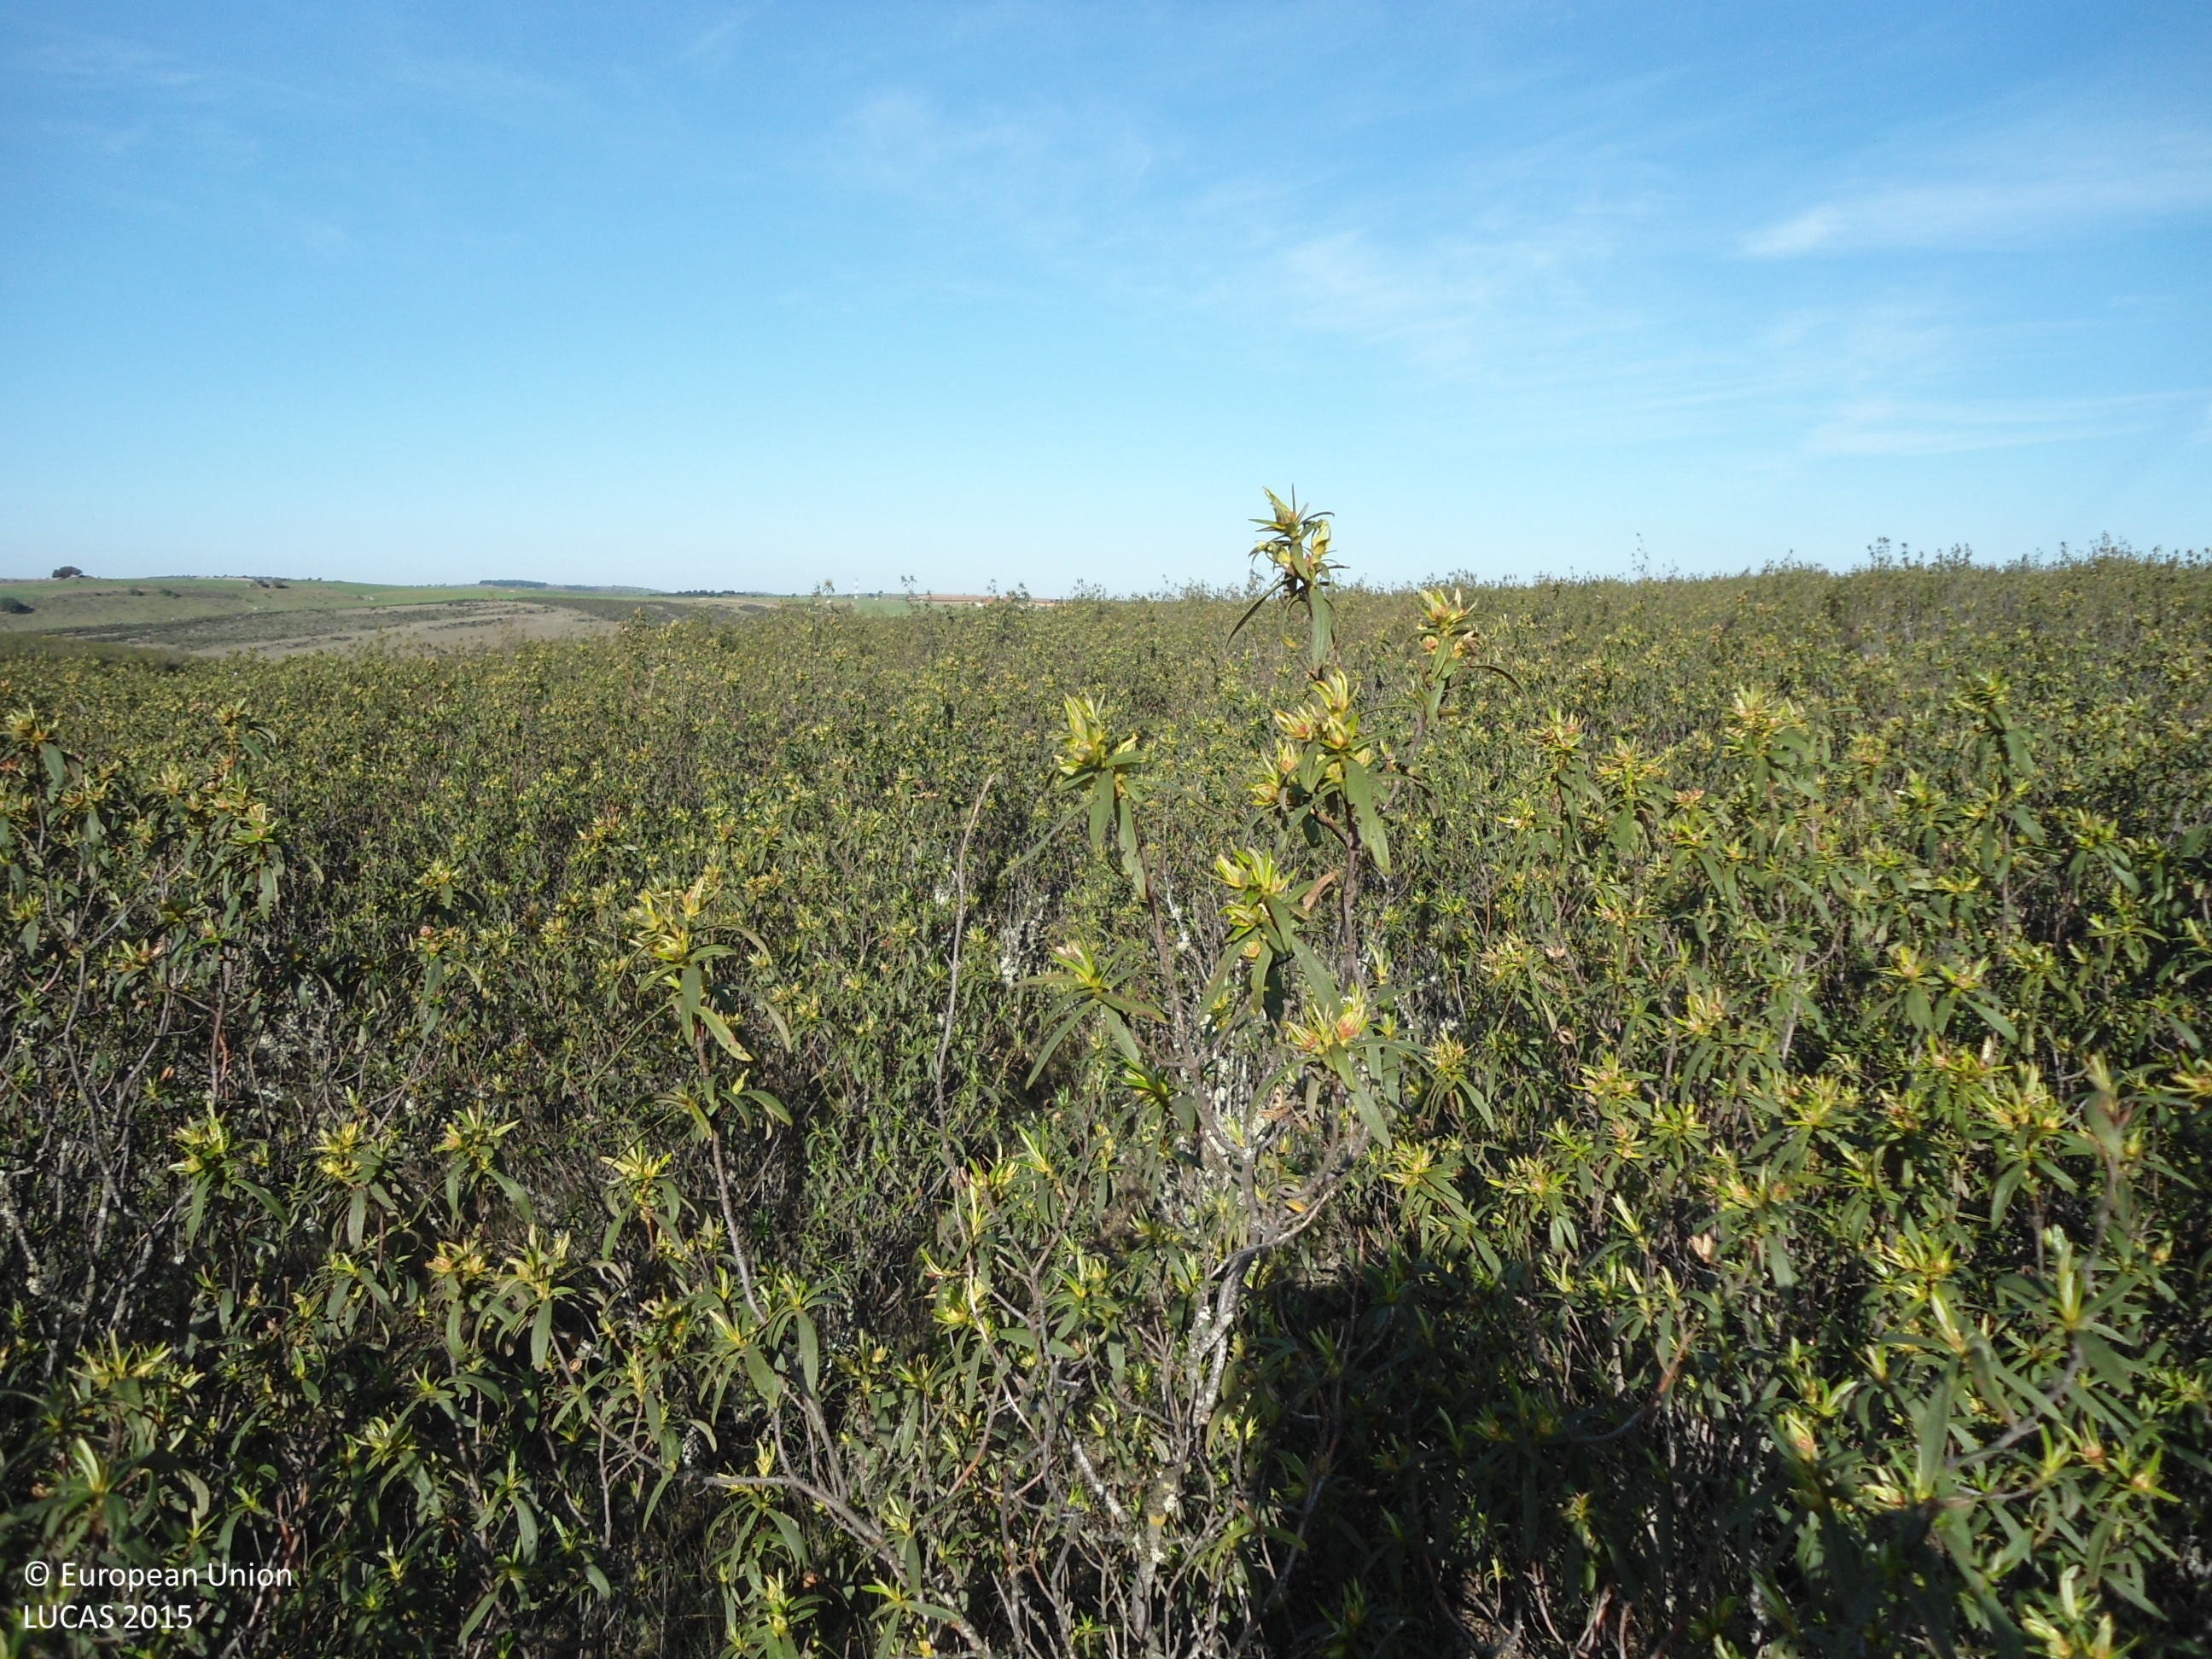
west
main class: Shrubland
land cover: Shrubland without tree cover
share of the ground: > 75 %
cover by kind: shrubs 100 %
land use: Semi-natural and natural areas not in use
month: April
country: ES
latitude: 41.6415
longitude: -5.9276
